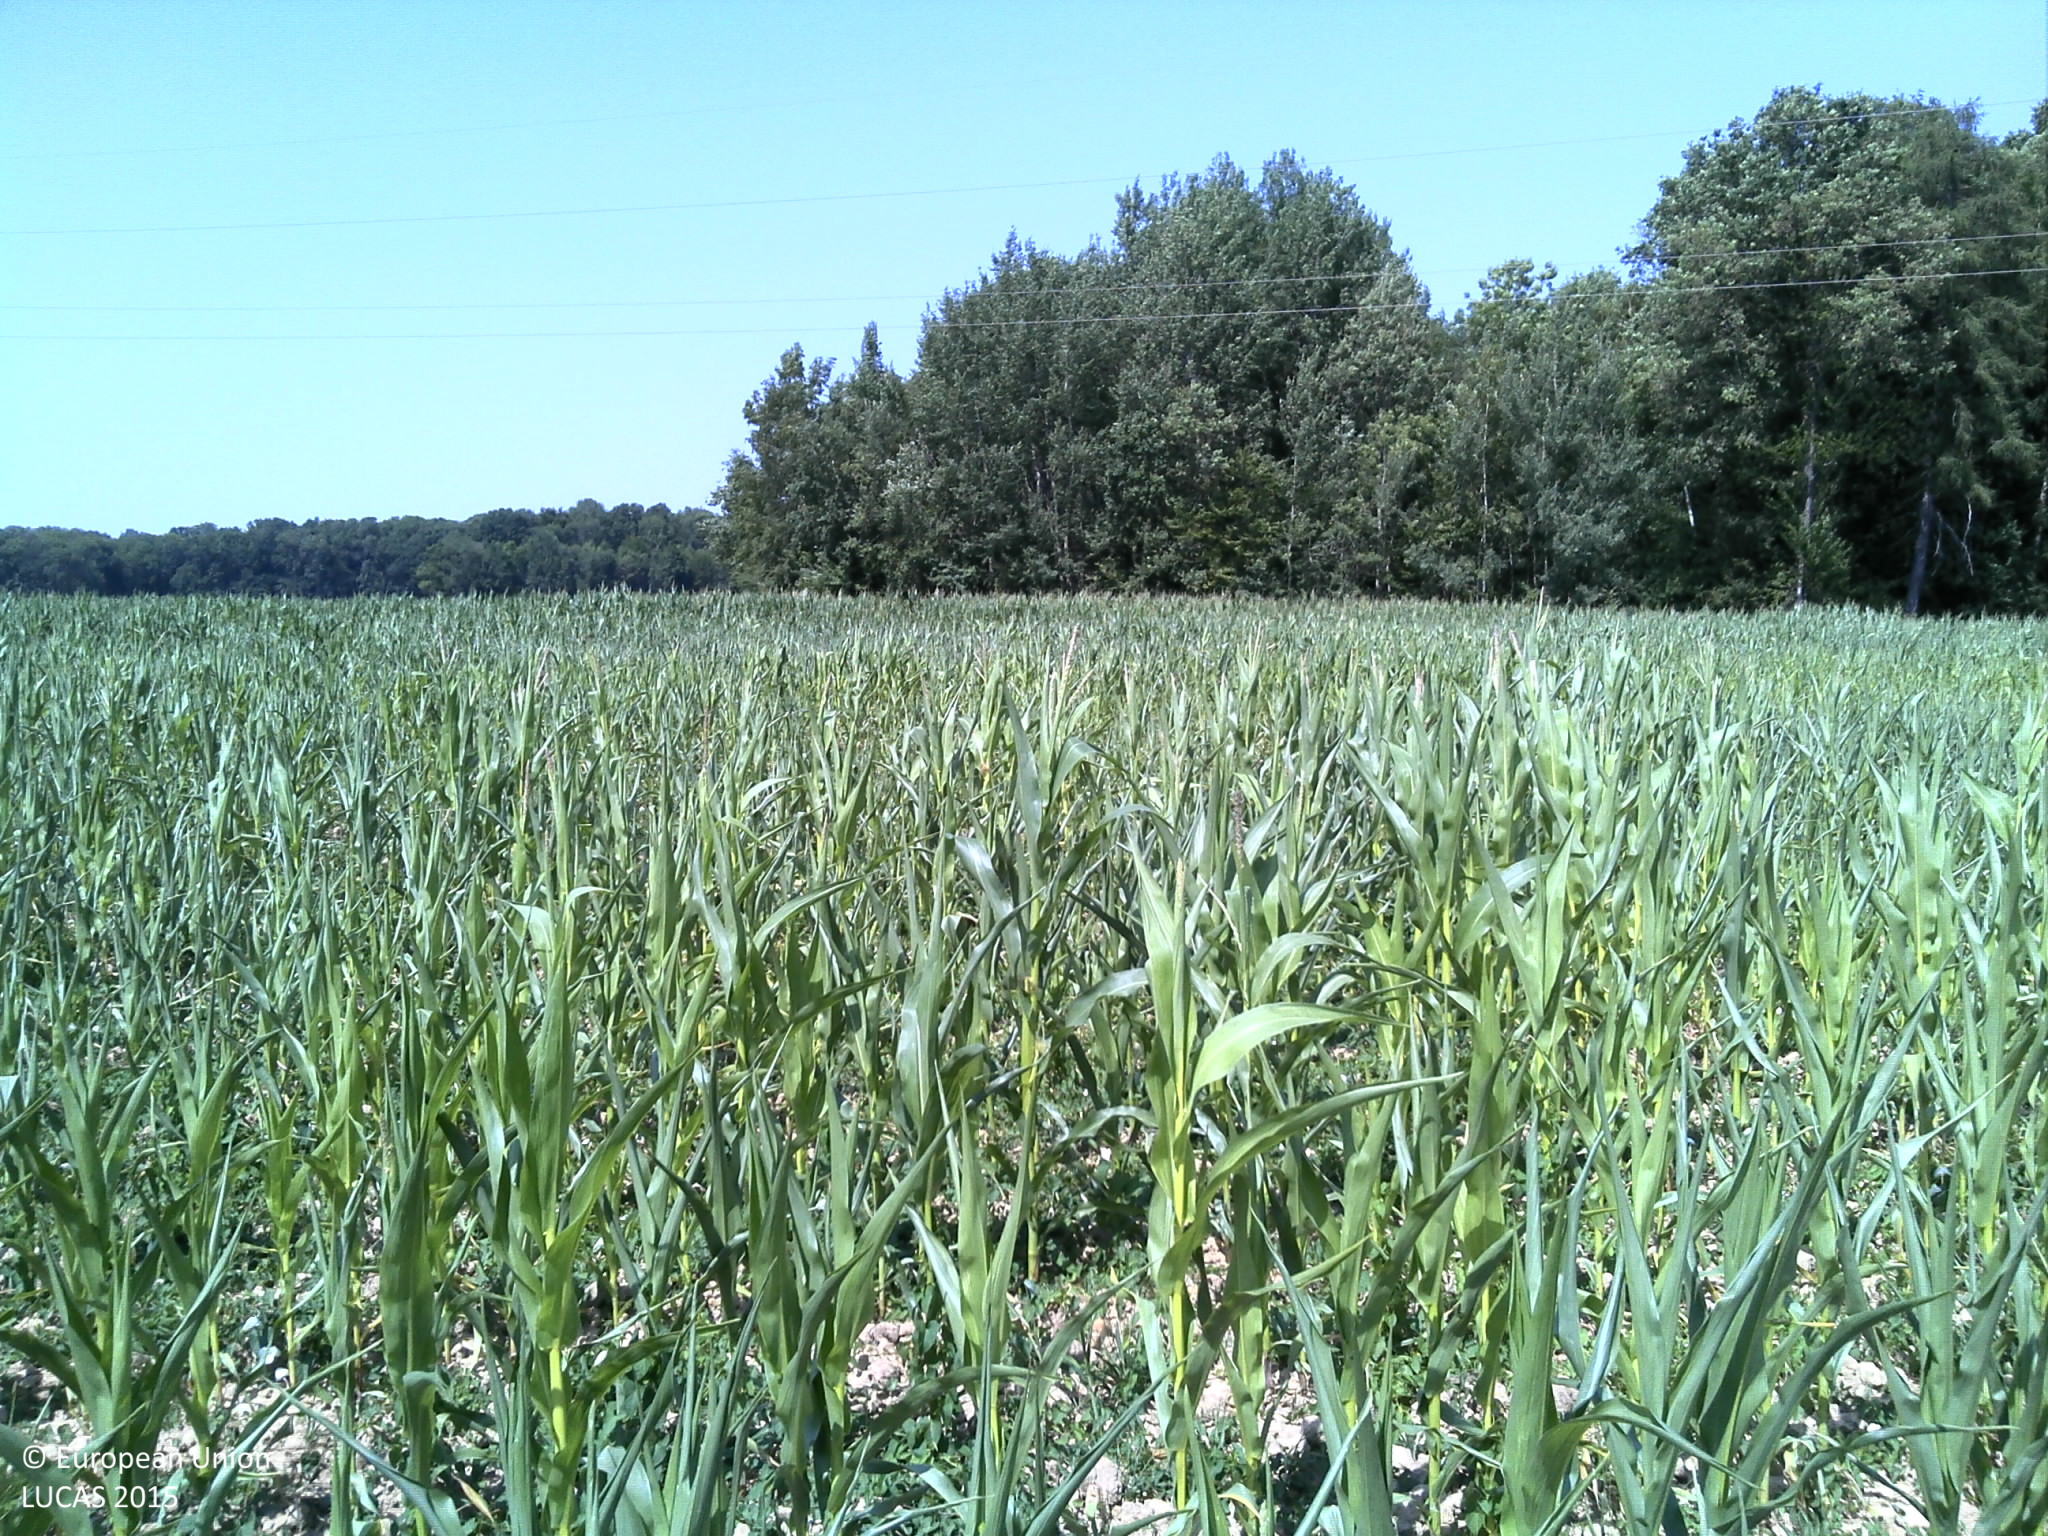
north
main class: Cropland
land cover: Maize
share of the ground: 50 - 75 %
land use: Agriculture (excluding fallow land and kitchen gardens)
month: July
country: FR
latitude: 48.8633
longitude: 4.9133
